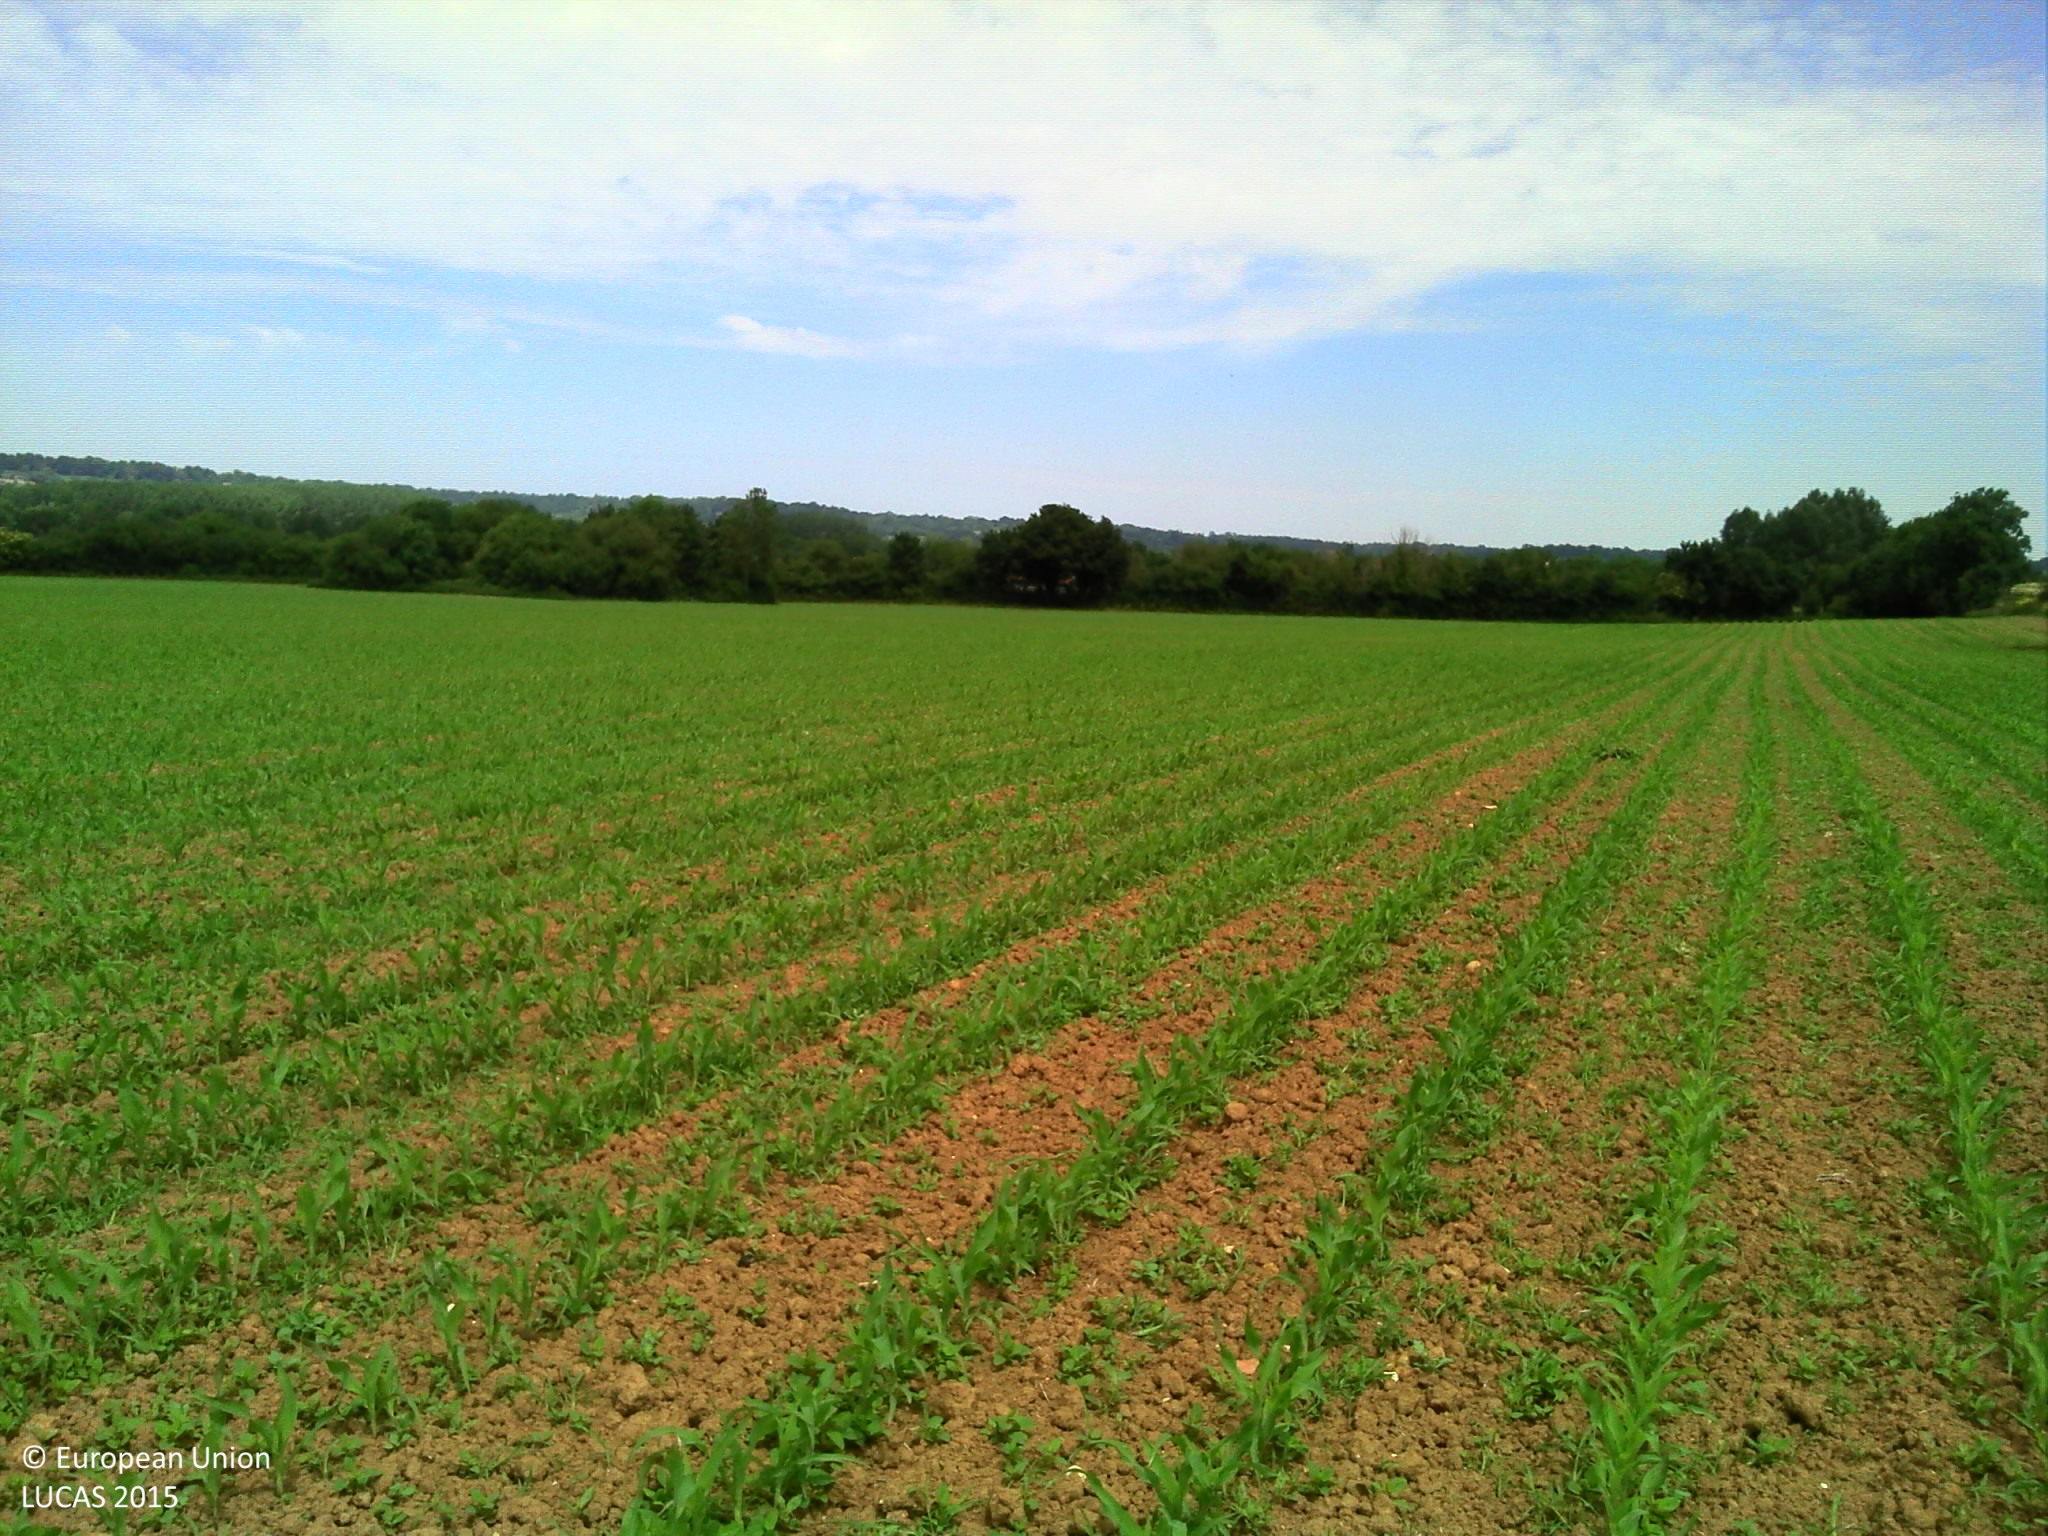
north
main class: Cropland
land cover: Maize
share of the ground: 10 - 25 %
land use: Agriculture (excluding fallow land and kitchen gardens)
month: June
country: FR
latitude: 49.1635
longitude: -0.0010
